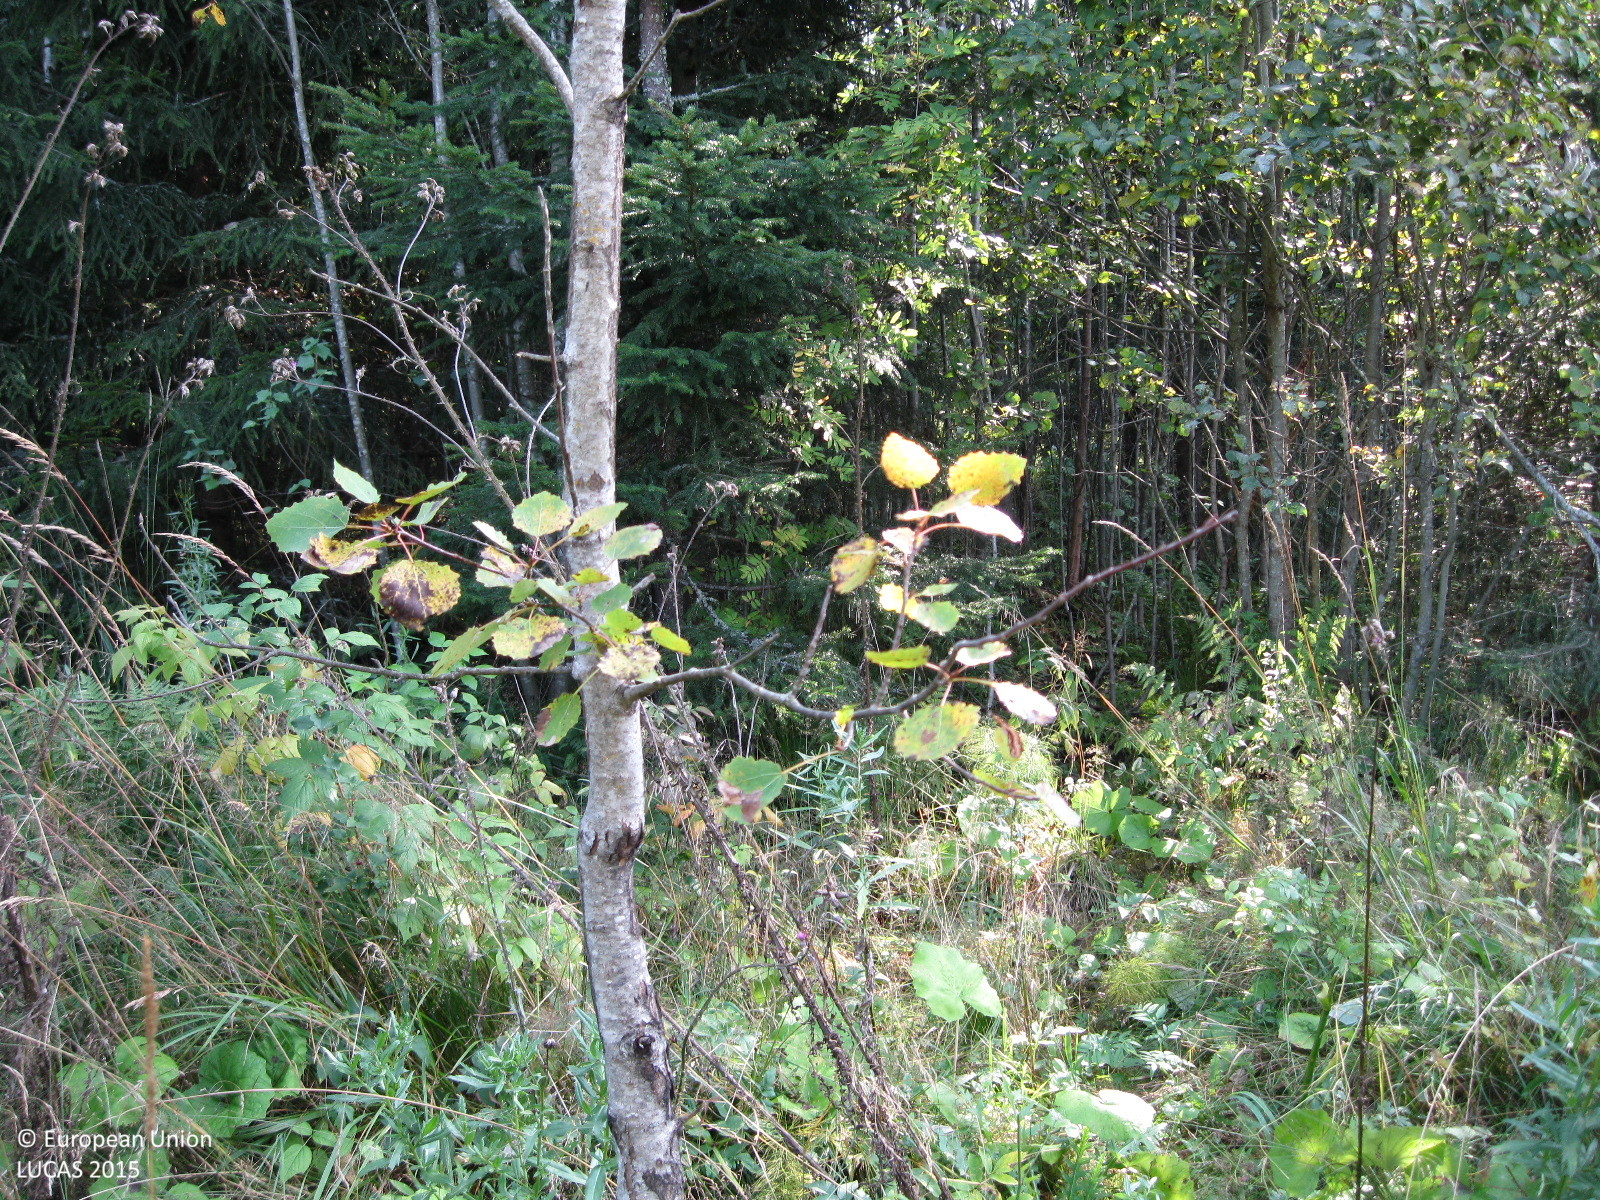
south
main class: Woodland
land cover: Broadleaved woodland
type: boreal forest
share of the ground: > 75 %
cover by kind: broadleaved forest trees 80 %, herbaceous plants 15 %, coniferous forest trees 5 %
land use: Forestry
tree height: > 5 m
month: September
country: FI
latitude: 60.5092
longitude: 24.8463
